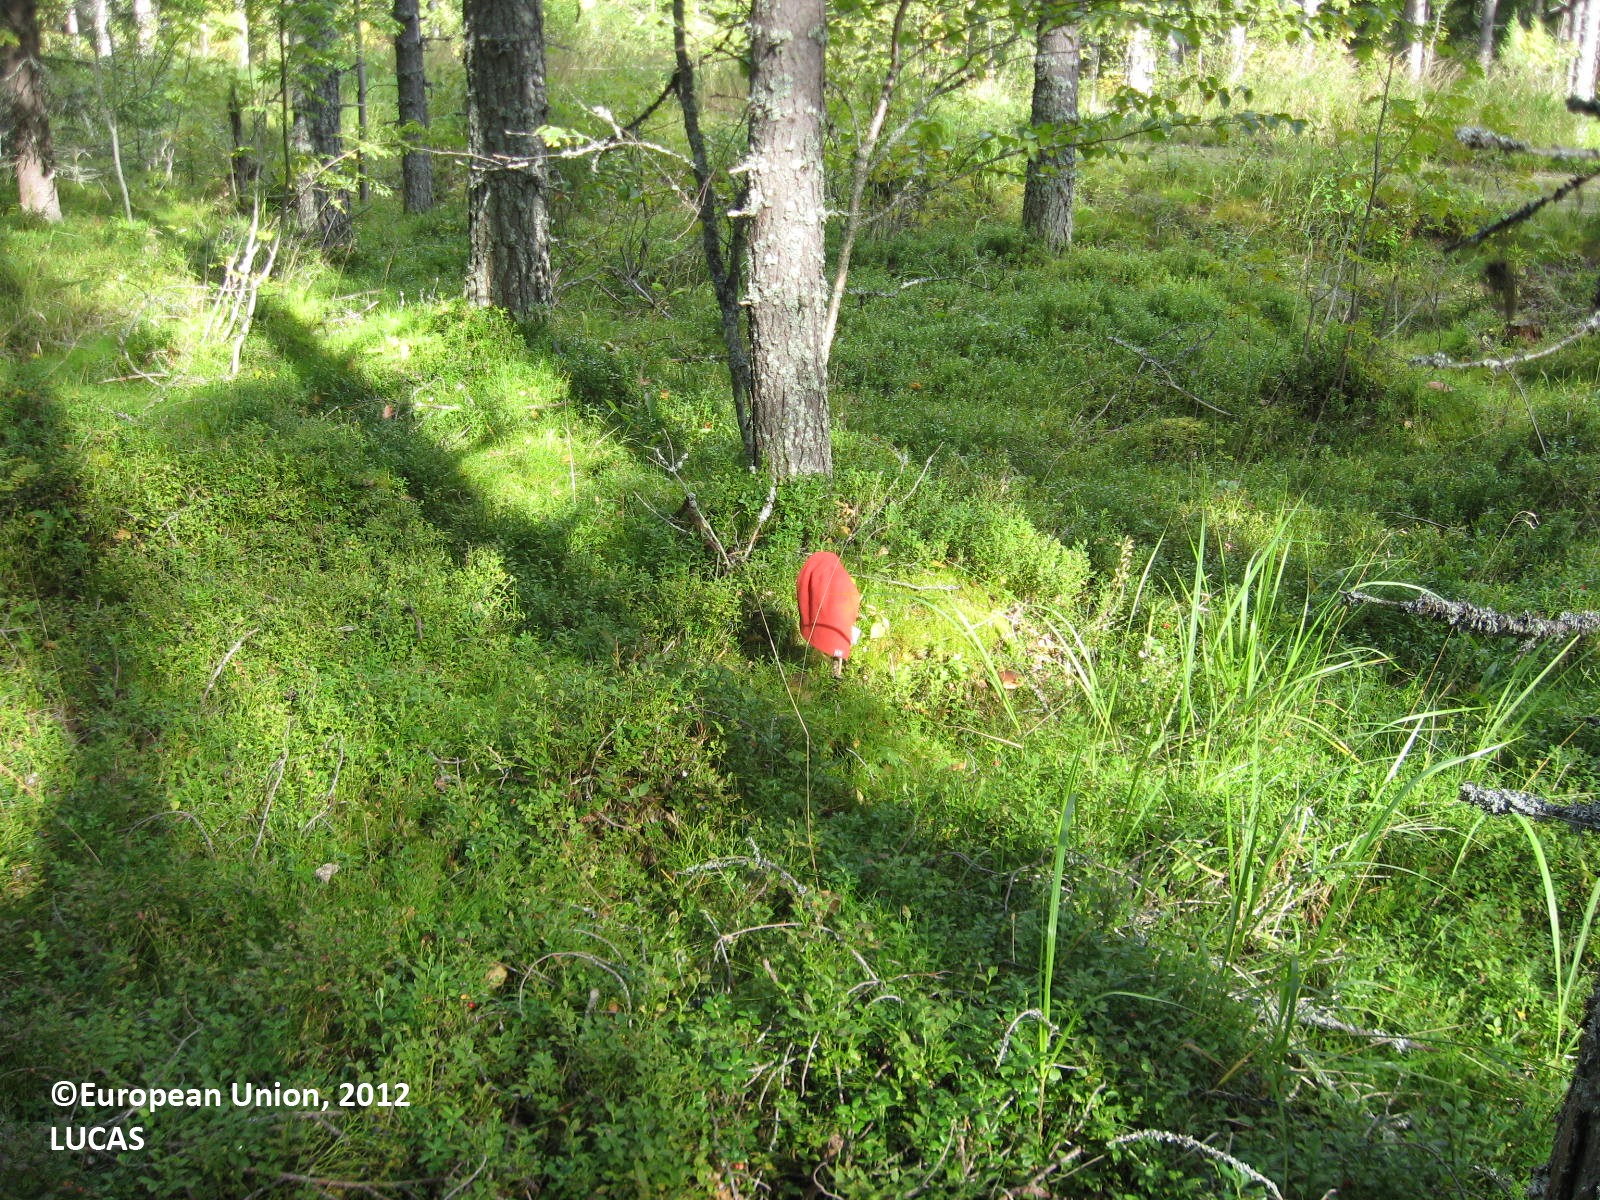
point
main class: Woodland
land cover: Pine dominated coniferous woodland
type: boreal forest
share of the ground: > 75 %
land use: Forestry
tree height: > 5 m
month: August
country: FI
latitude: 63.6163
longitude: 29.3613
